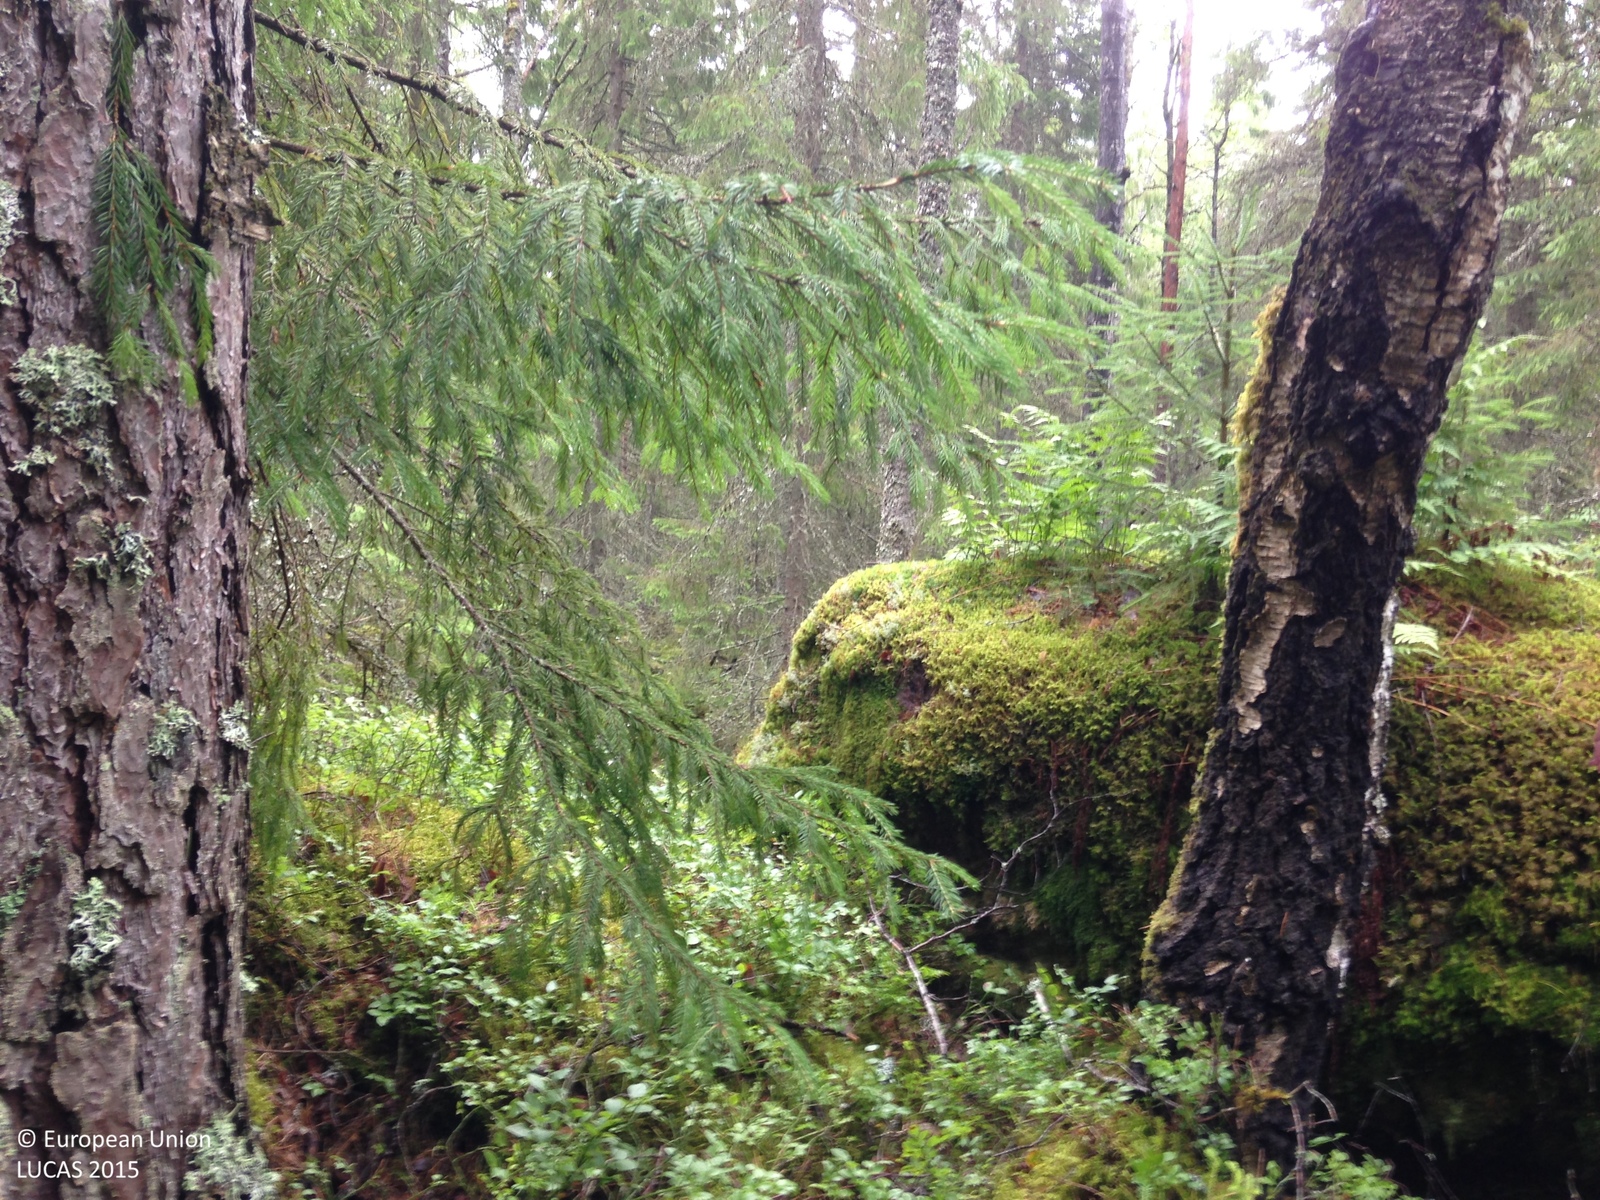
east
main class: Woodland
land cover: Other mixed woodland
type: boreal forest
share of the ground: 25 - 50 %
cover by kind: herbaceous plants 40 %, coniferous forest trees 25 %, lichens and mosses 20 %, broadleaved forest trees 15 %
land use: Amenities, museums, leisure
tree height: > 5 m
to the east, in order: Other mixed woodland; Spruce dominated mixed woodland; Pine dominated mixed woodland; Other mixed woodland
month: July
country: SE
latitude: 58.8824
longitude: 14.5205
